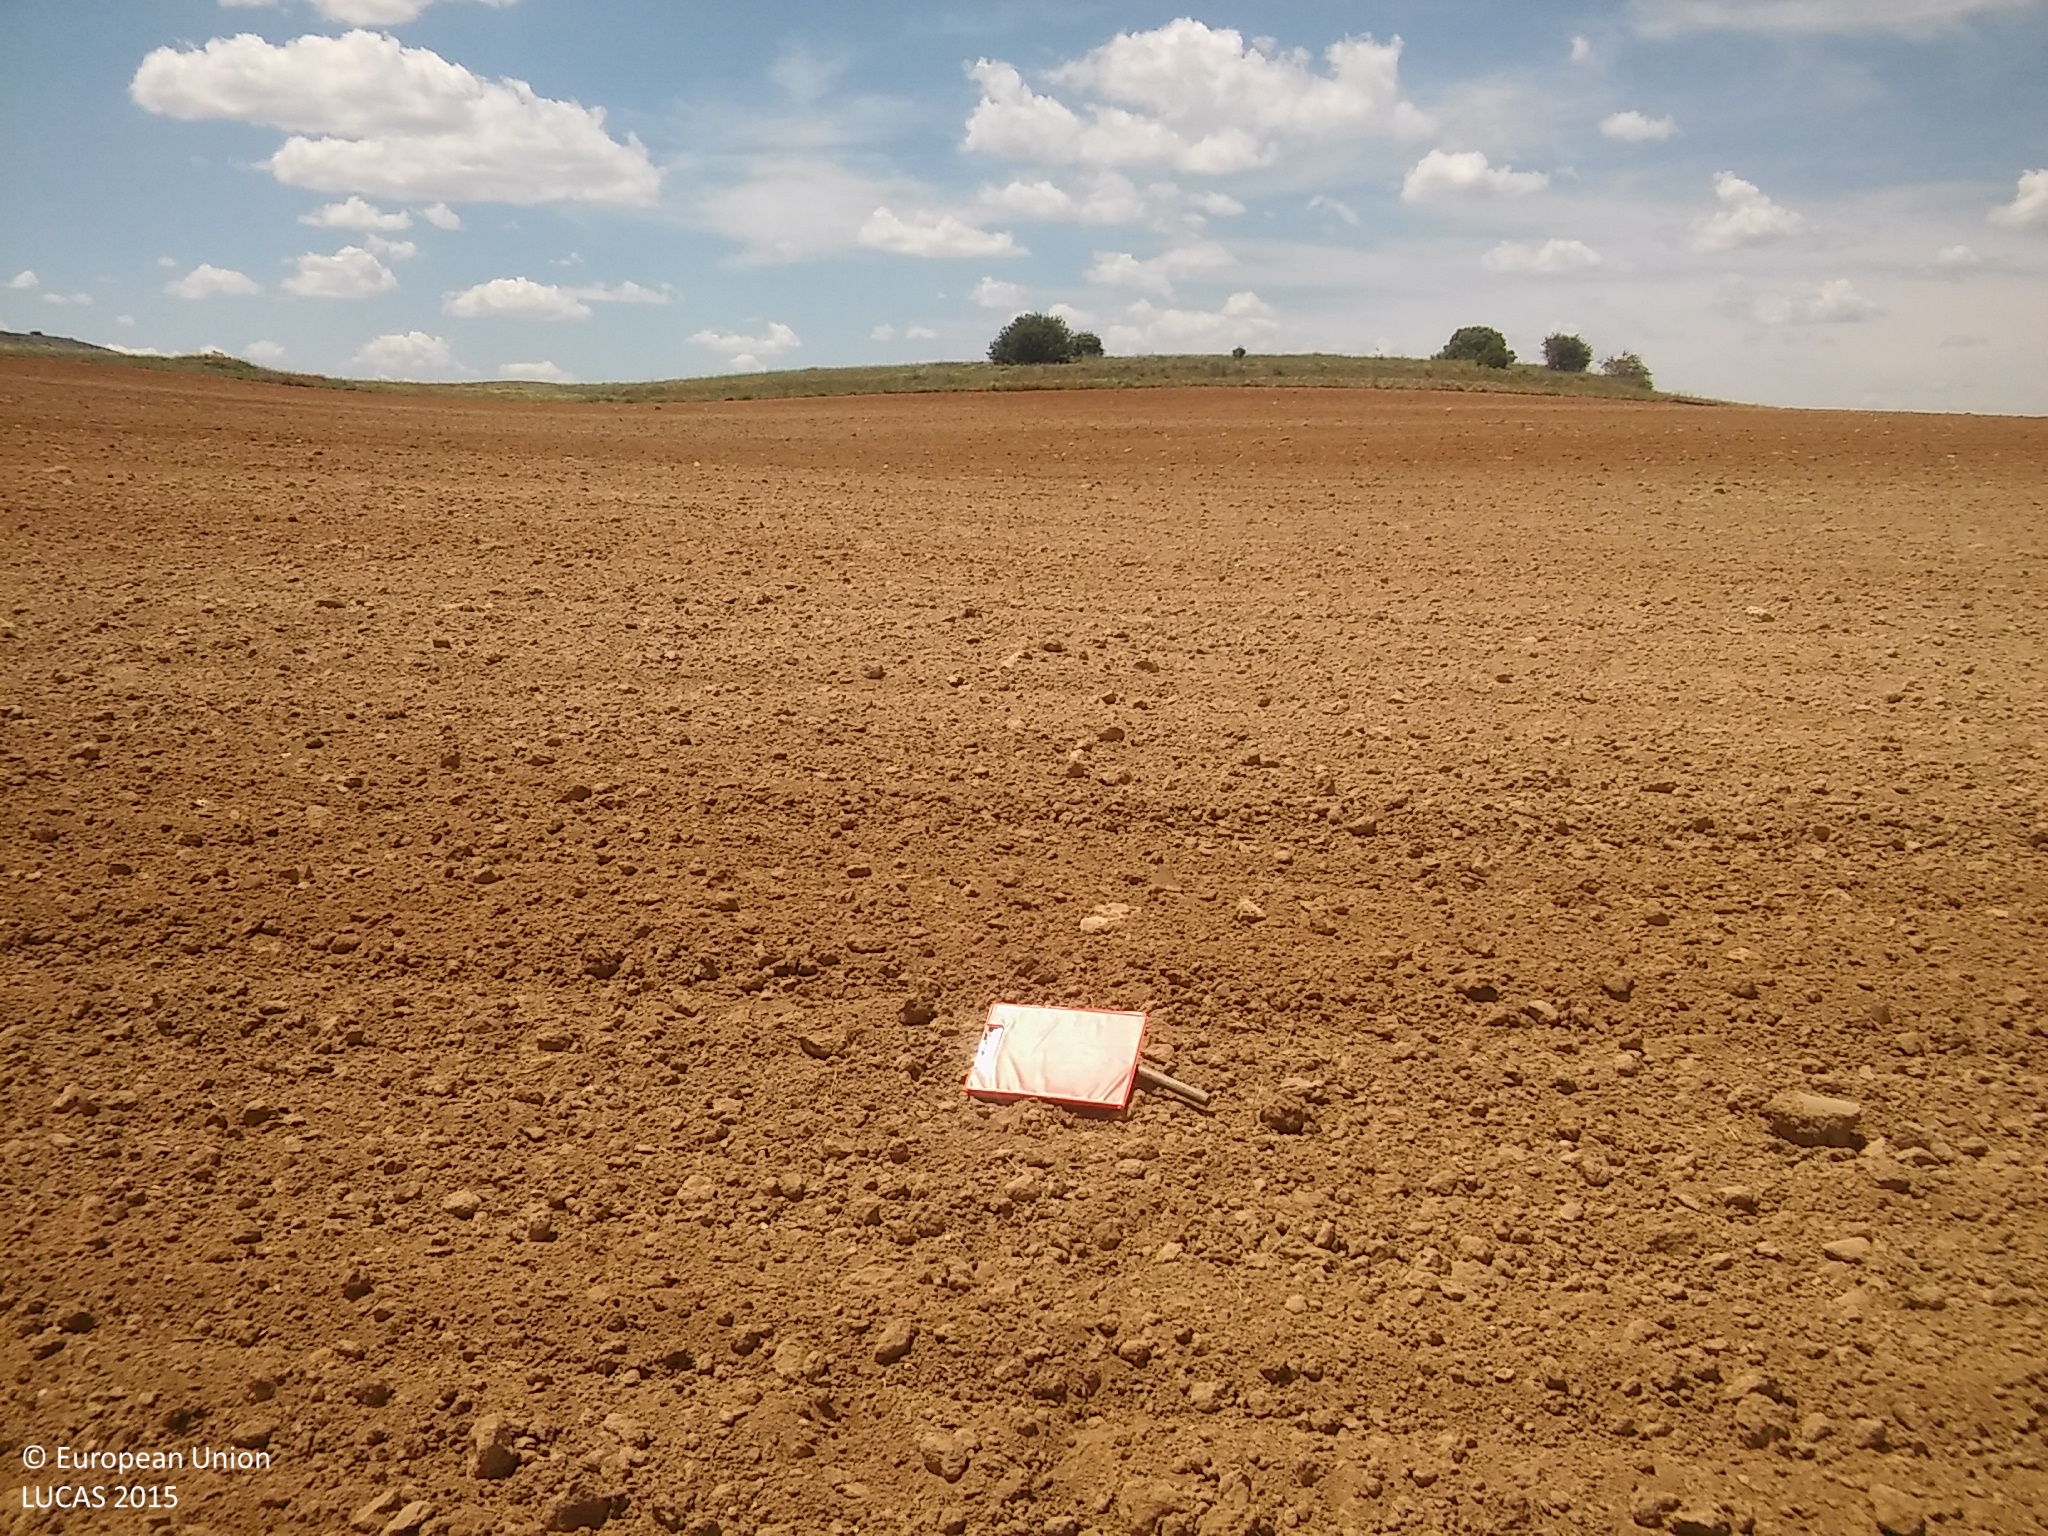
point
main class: Cropland
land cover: Sunflower
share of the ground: < 10 %
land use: Agriculture (excluding fallow land and kitchen gardens)
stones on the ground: < 10 %
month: June
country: ES
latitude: 41.6347
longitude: -3.7746
